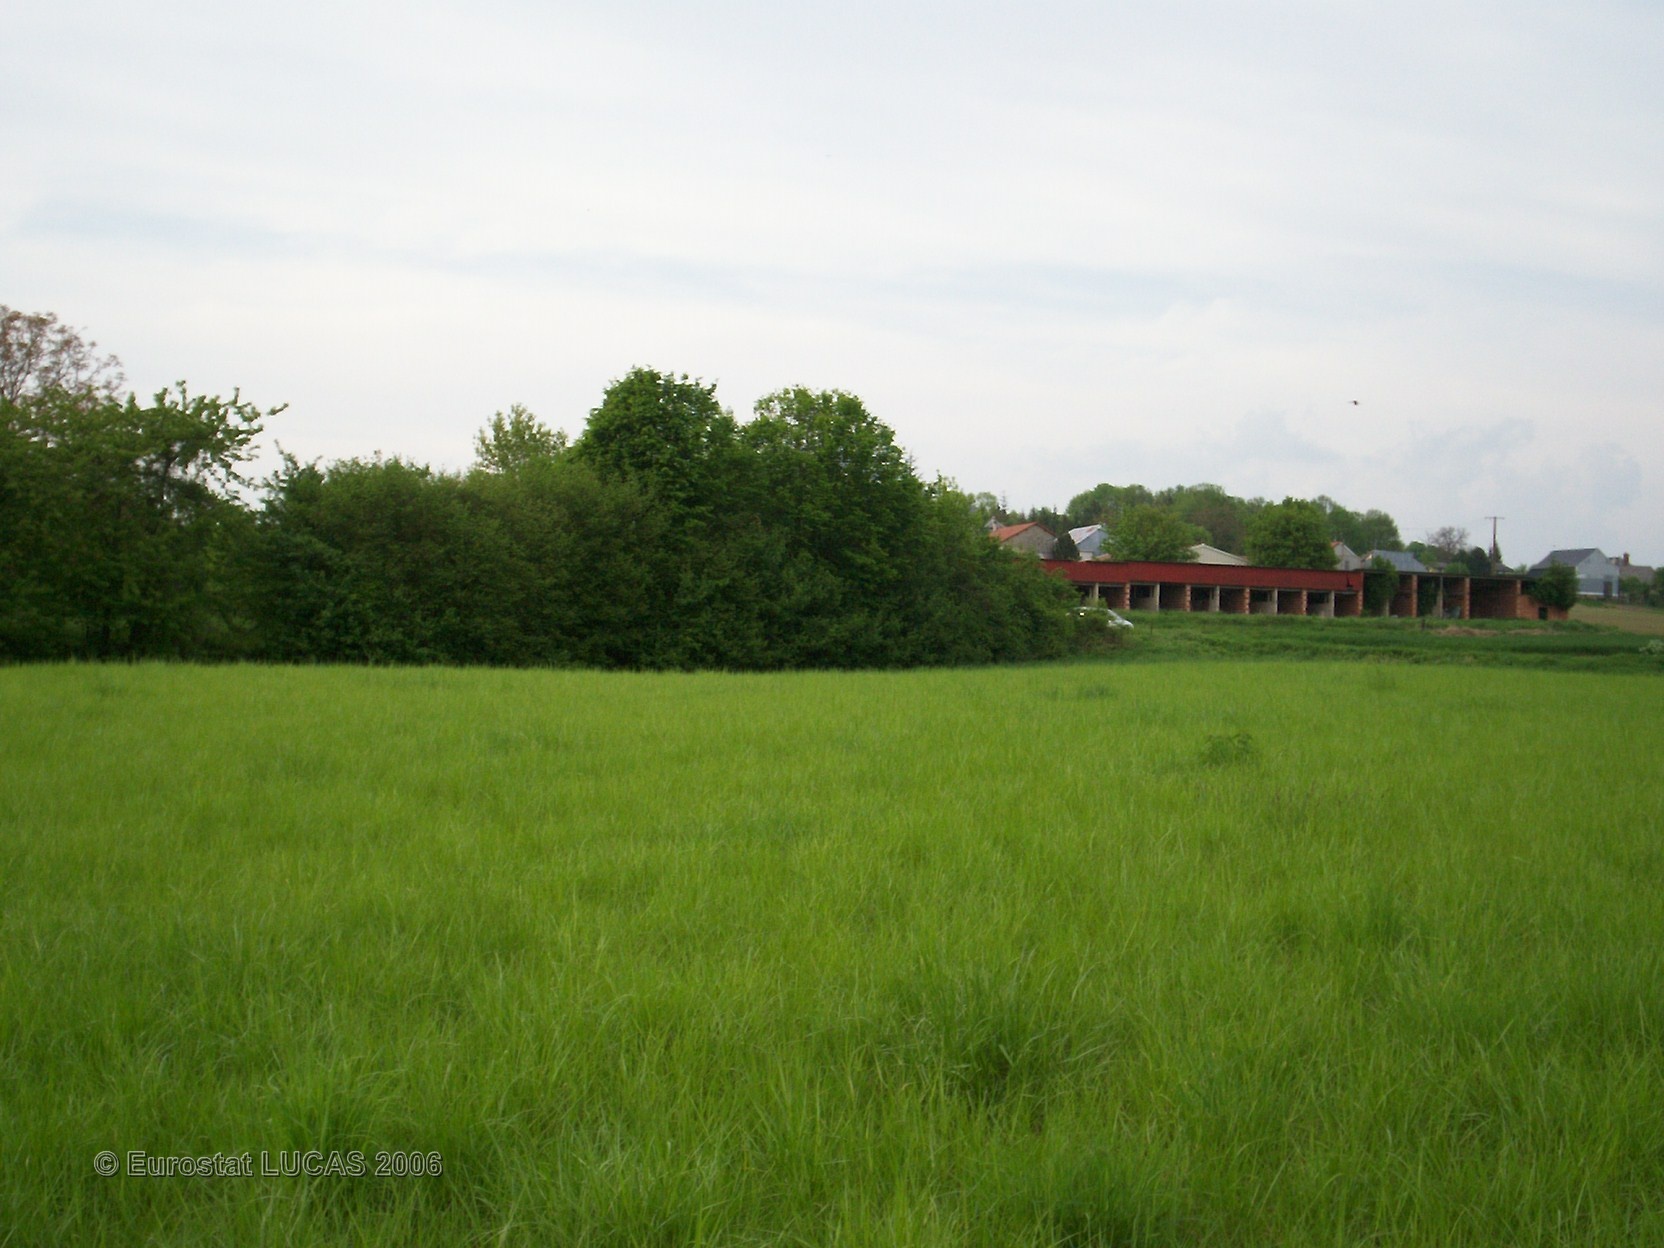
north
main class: Grassland
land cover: Grassland without tree/shrub cover
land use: Agriculture (excluding fallow land and kitchen gardens)
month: May
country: FR
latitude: 49.5556
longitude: 4.3141
